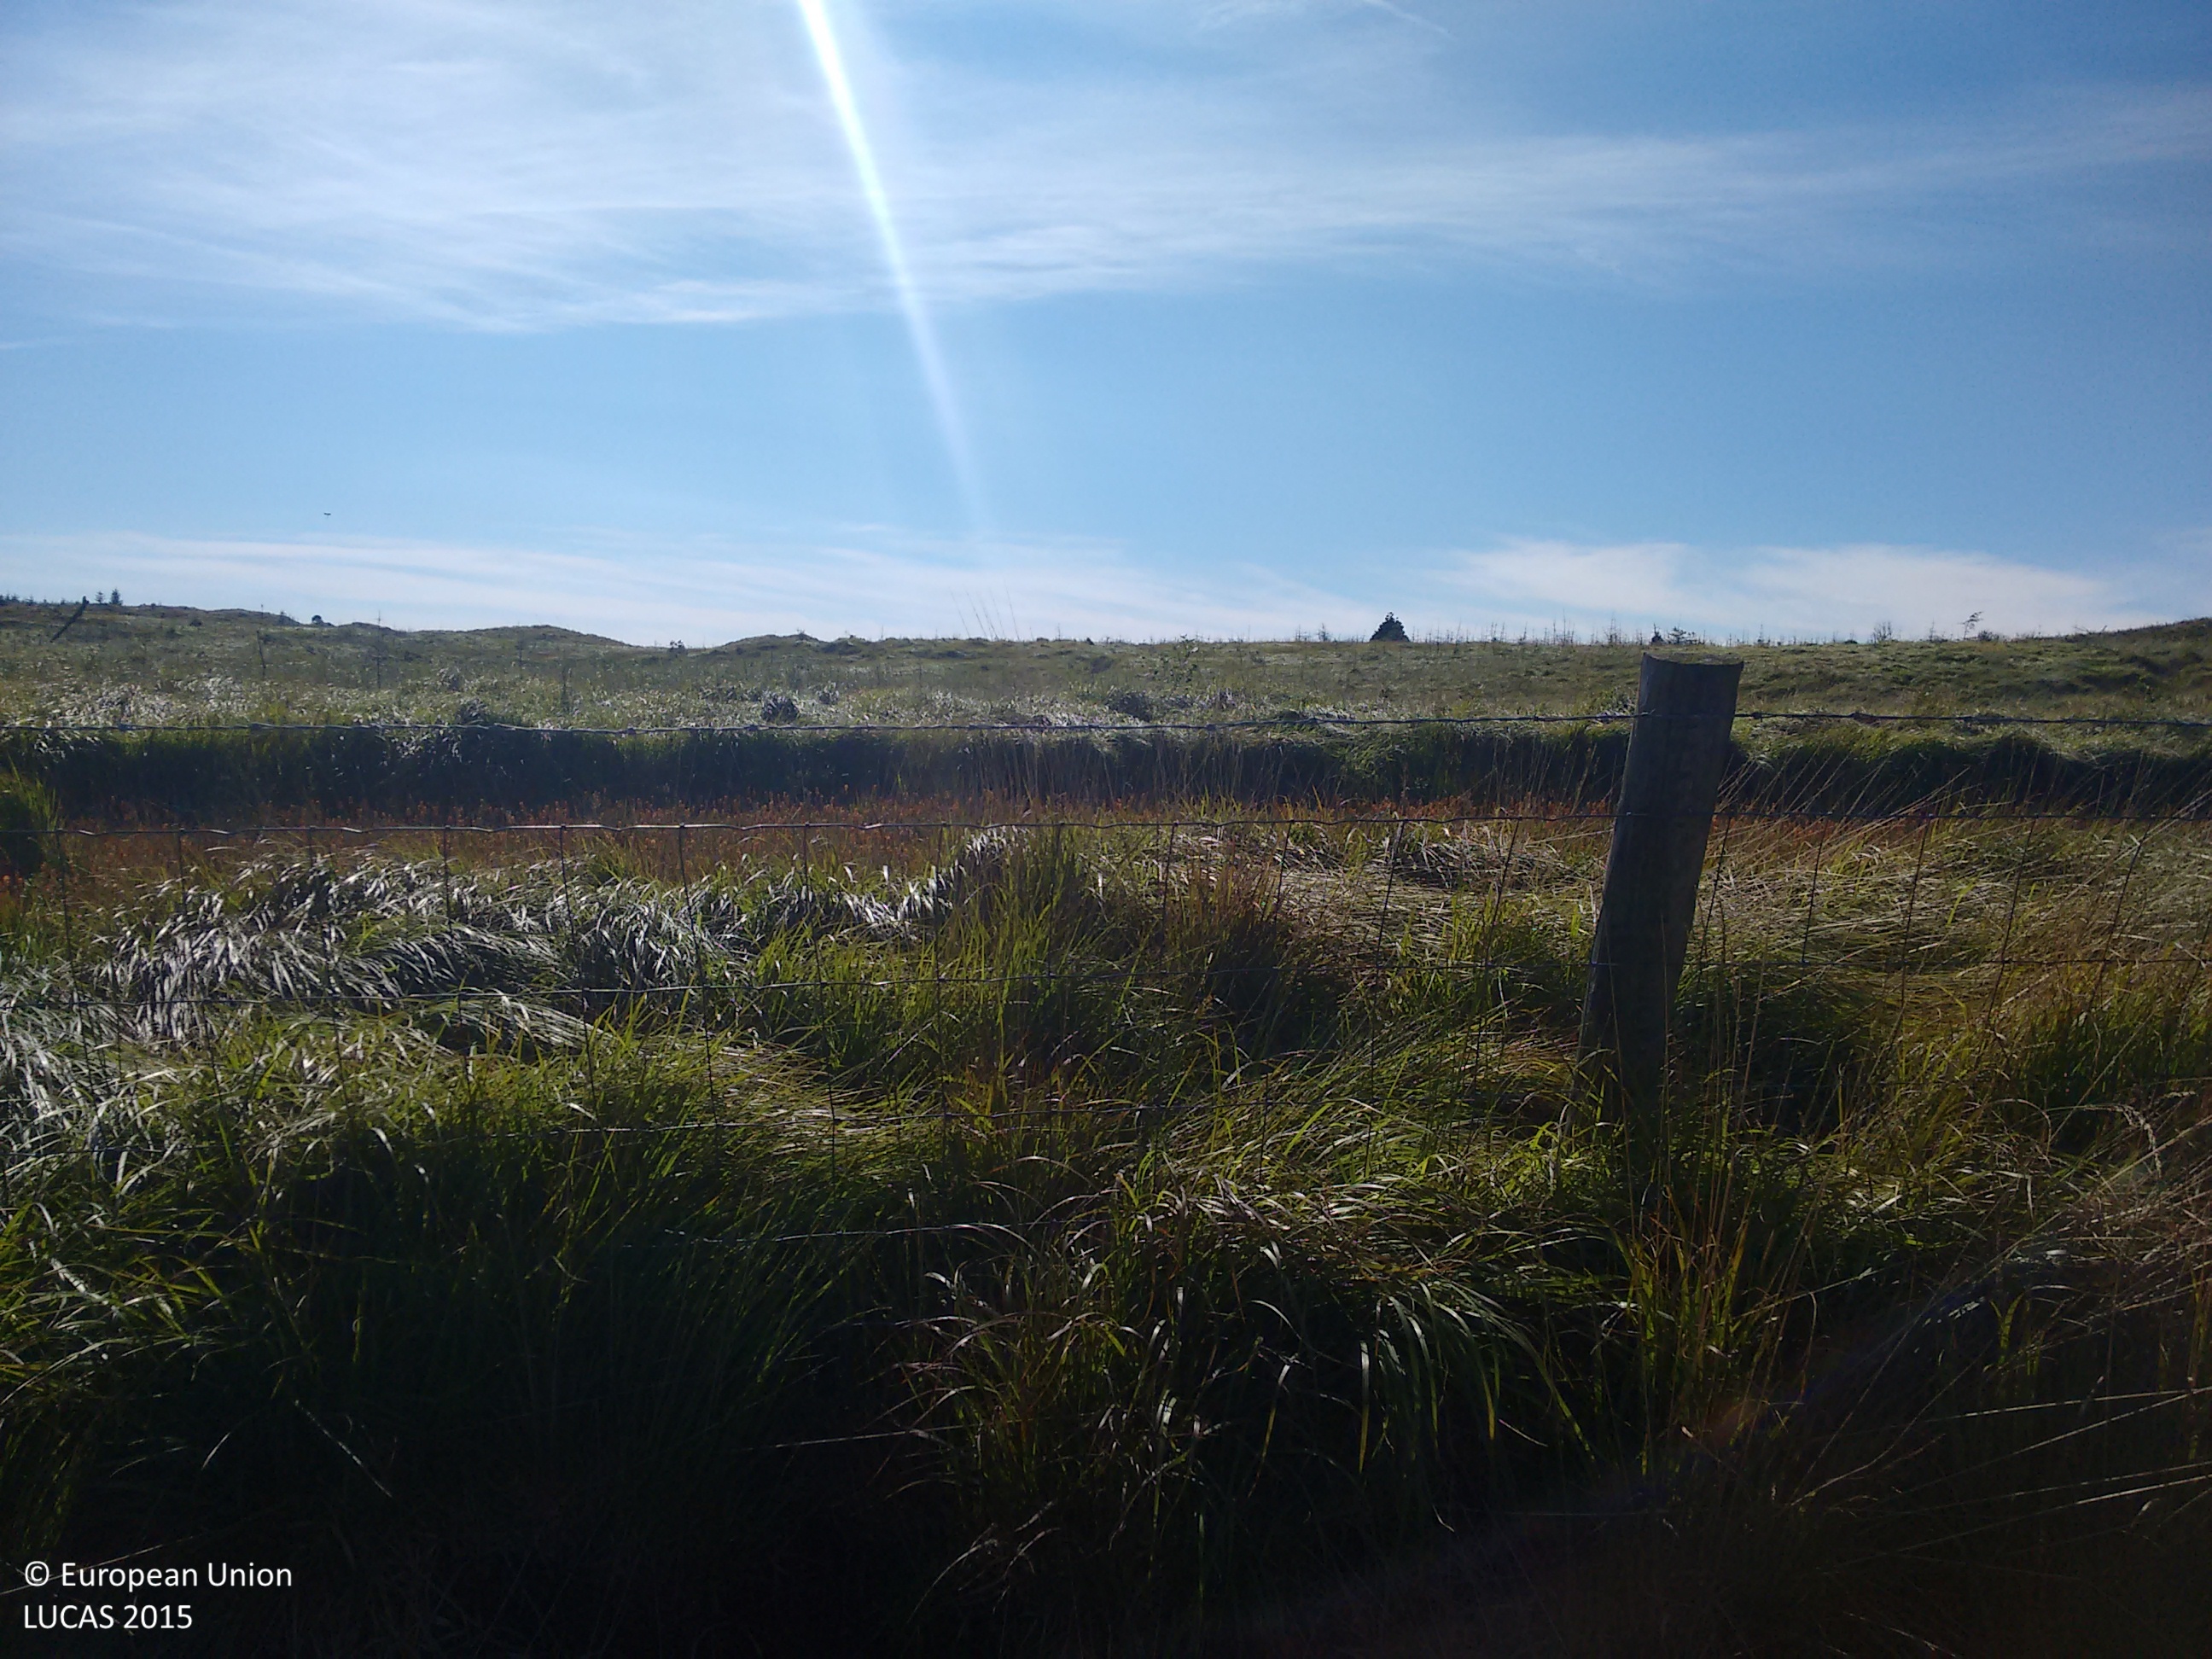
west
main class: Grassland
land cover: Spontaneously vegetated surfaces
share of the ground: > 75 %
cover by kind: herbaceous plants 70 %, unconsolidated bare surface 30 %
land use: Semi-natural and natural areas not in use
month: August
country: IE
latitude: 51.6199
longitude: -9.4251
